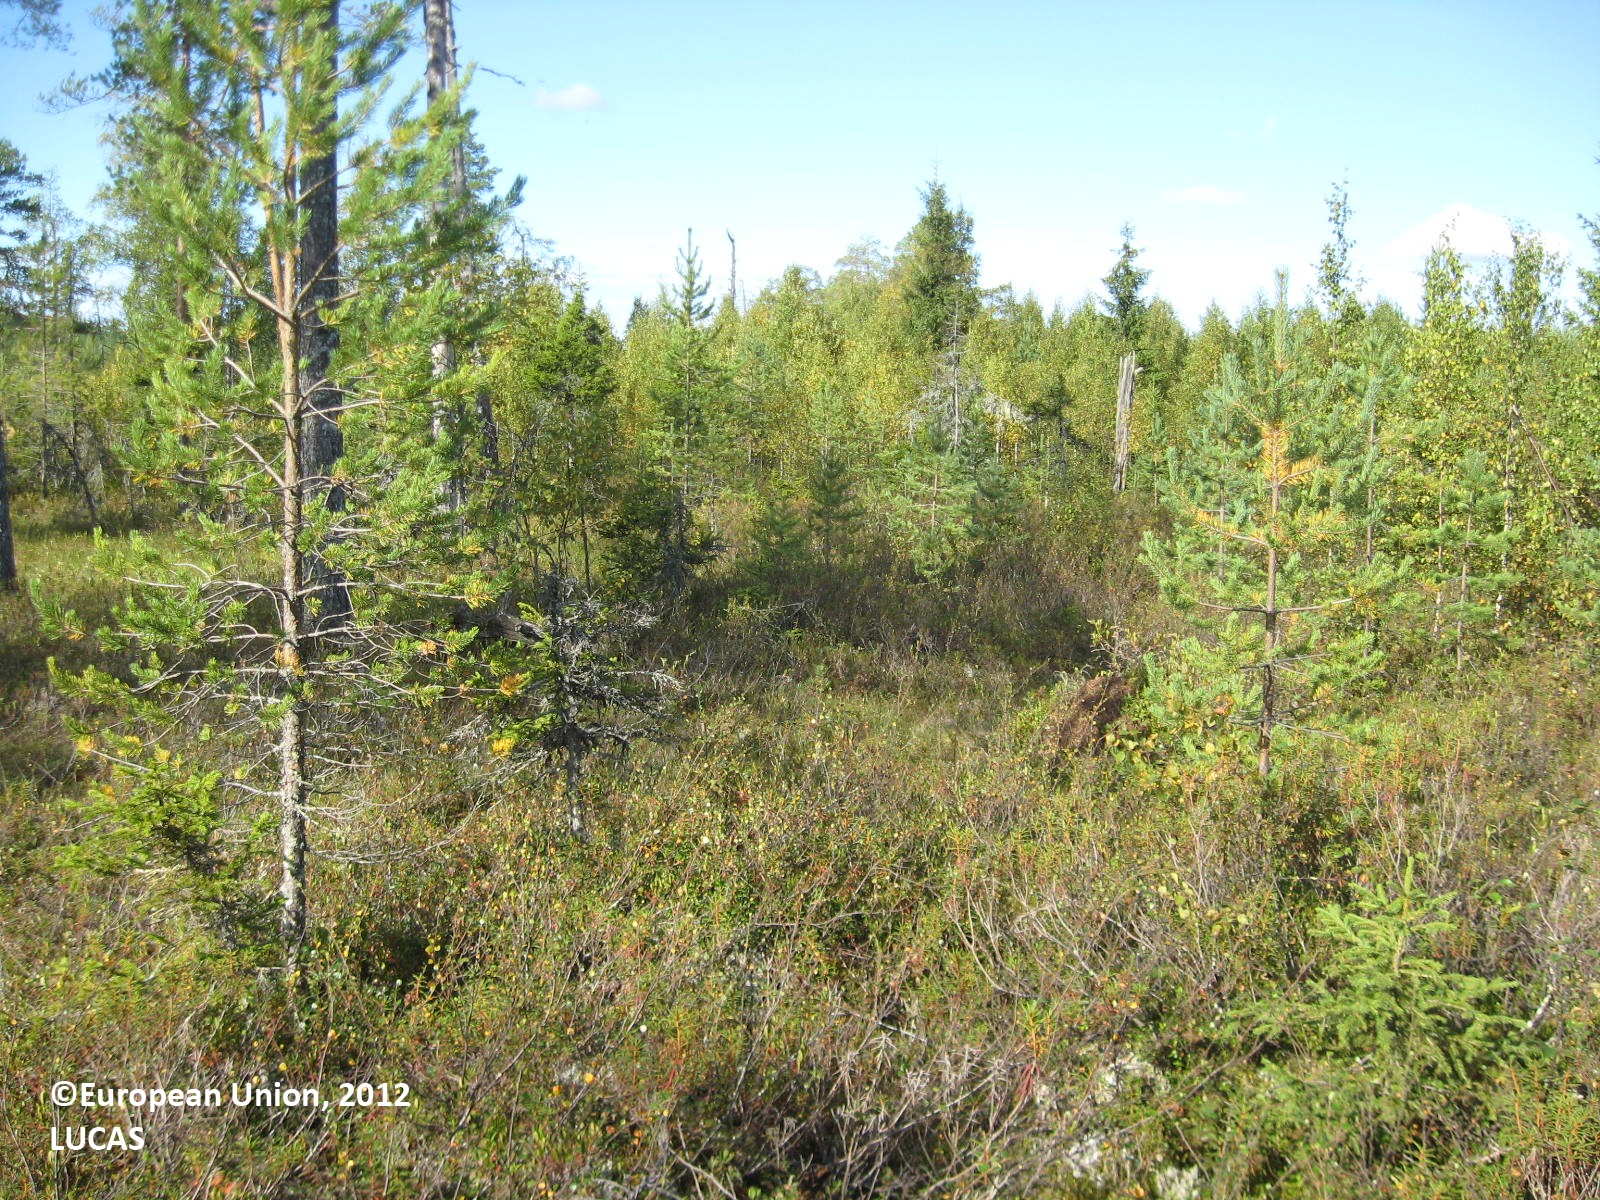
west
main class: Woodland
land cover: Other coniferous woodland
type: boreal forest
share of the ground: 50 - 75 %
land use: Forestry
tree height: < 5 m
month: August
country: FI
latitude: 63.7930
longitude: 29.7373
